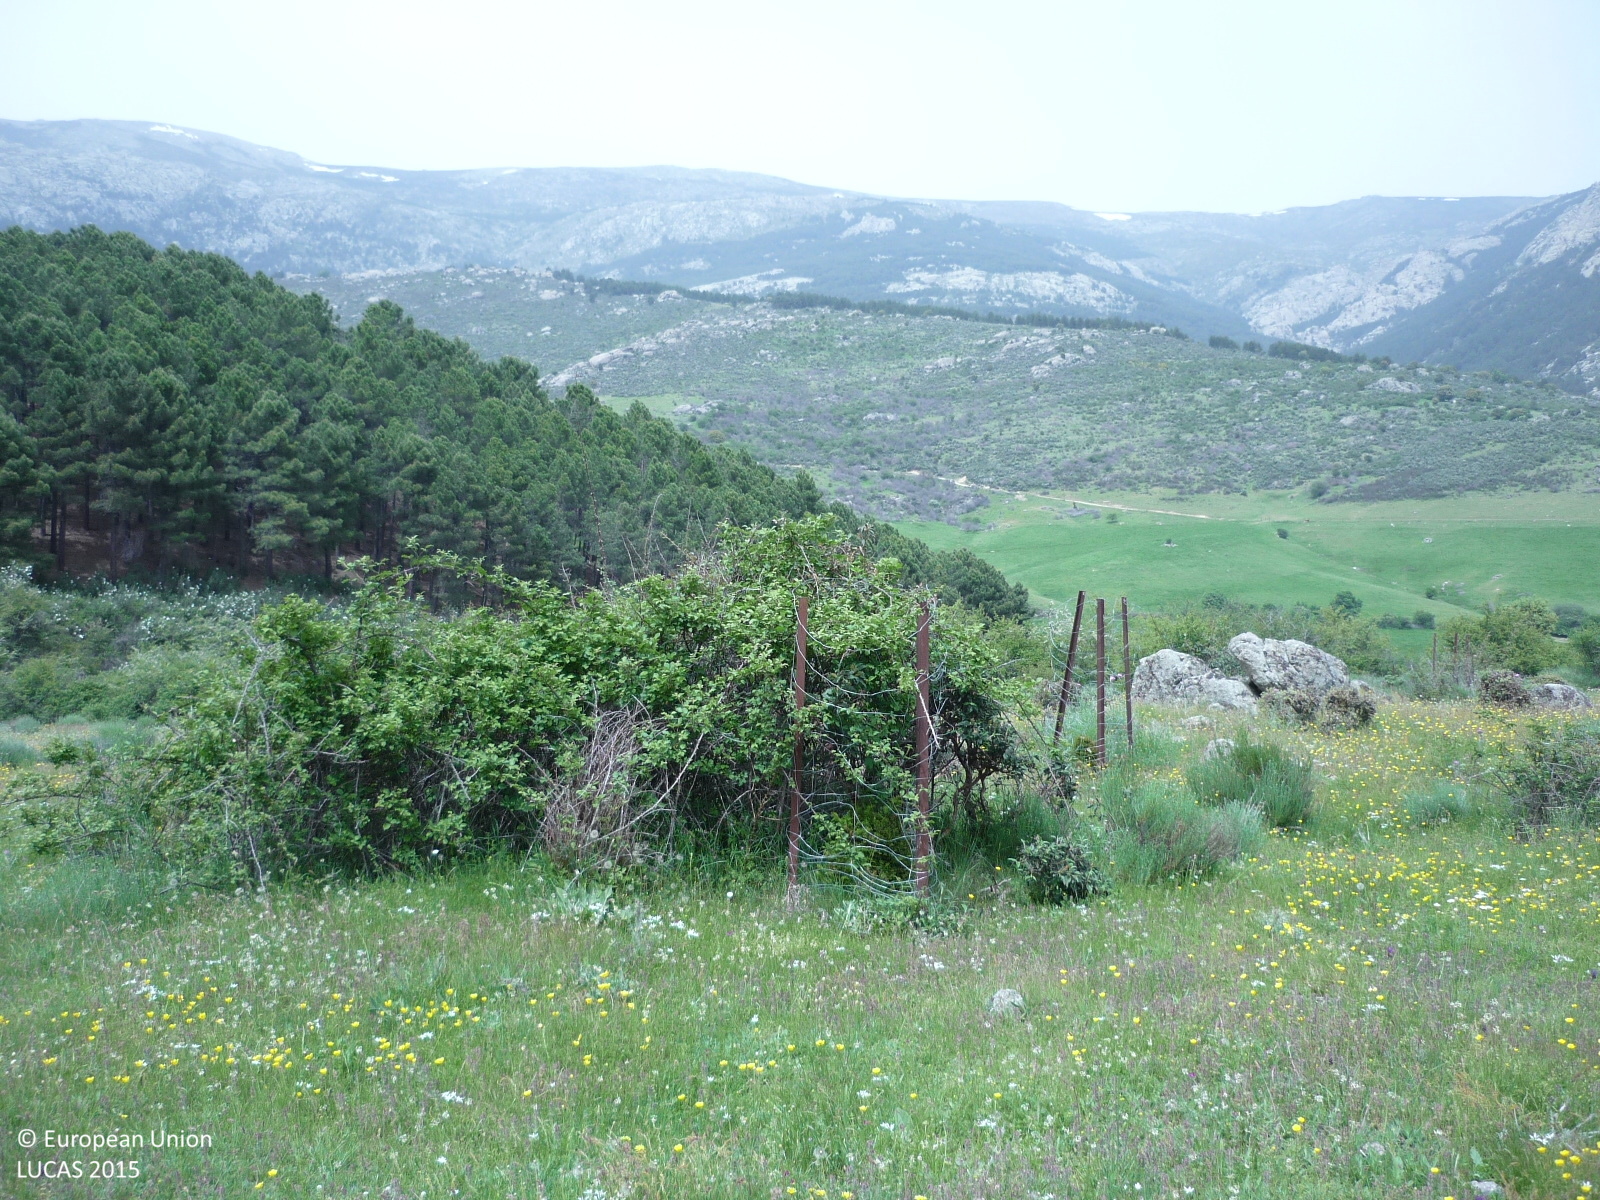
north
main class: Grassland
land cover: Grassland without tree/shrub cover
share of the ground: > 75 %
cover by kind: herbaceous plants 90 %, shrubs 5 %, unconsolidated bare surface 5 %
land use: Agriculture (excluding fallow land and kitchen gardens)
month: May
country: ES
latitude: 40.7546
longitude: -3.9149
